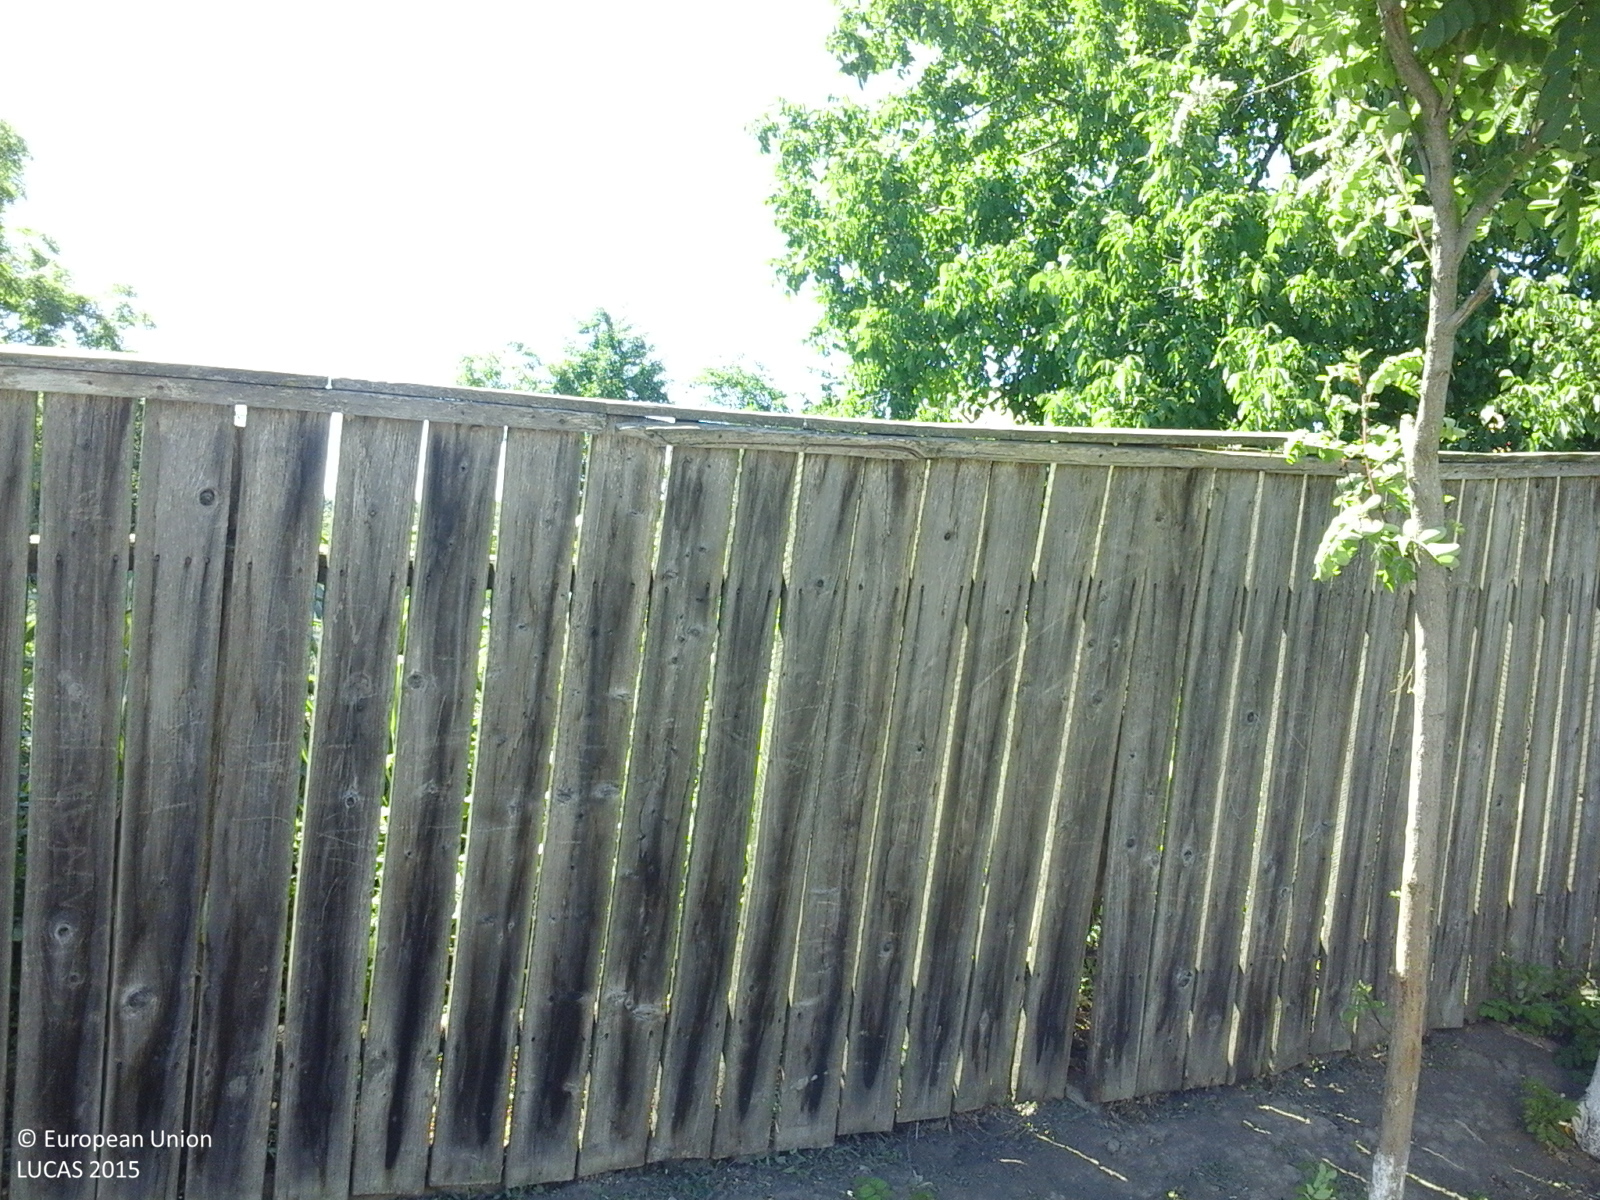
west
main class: Cropland
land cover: Maize
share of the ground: > 75 %
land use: Agriculture (excluding fallow land and kitchen gardens)
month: June
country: RO
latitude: 47.1536
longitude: 27.0771
